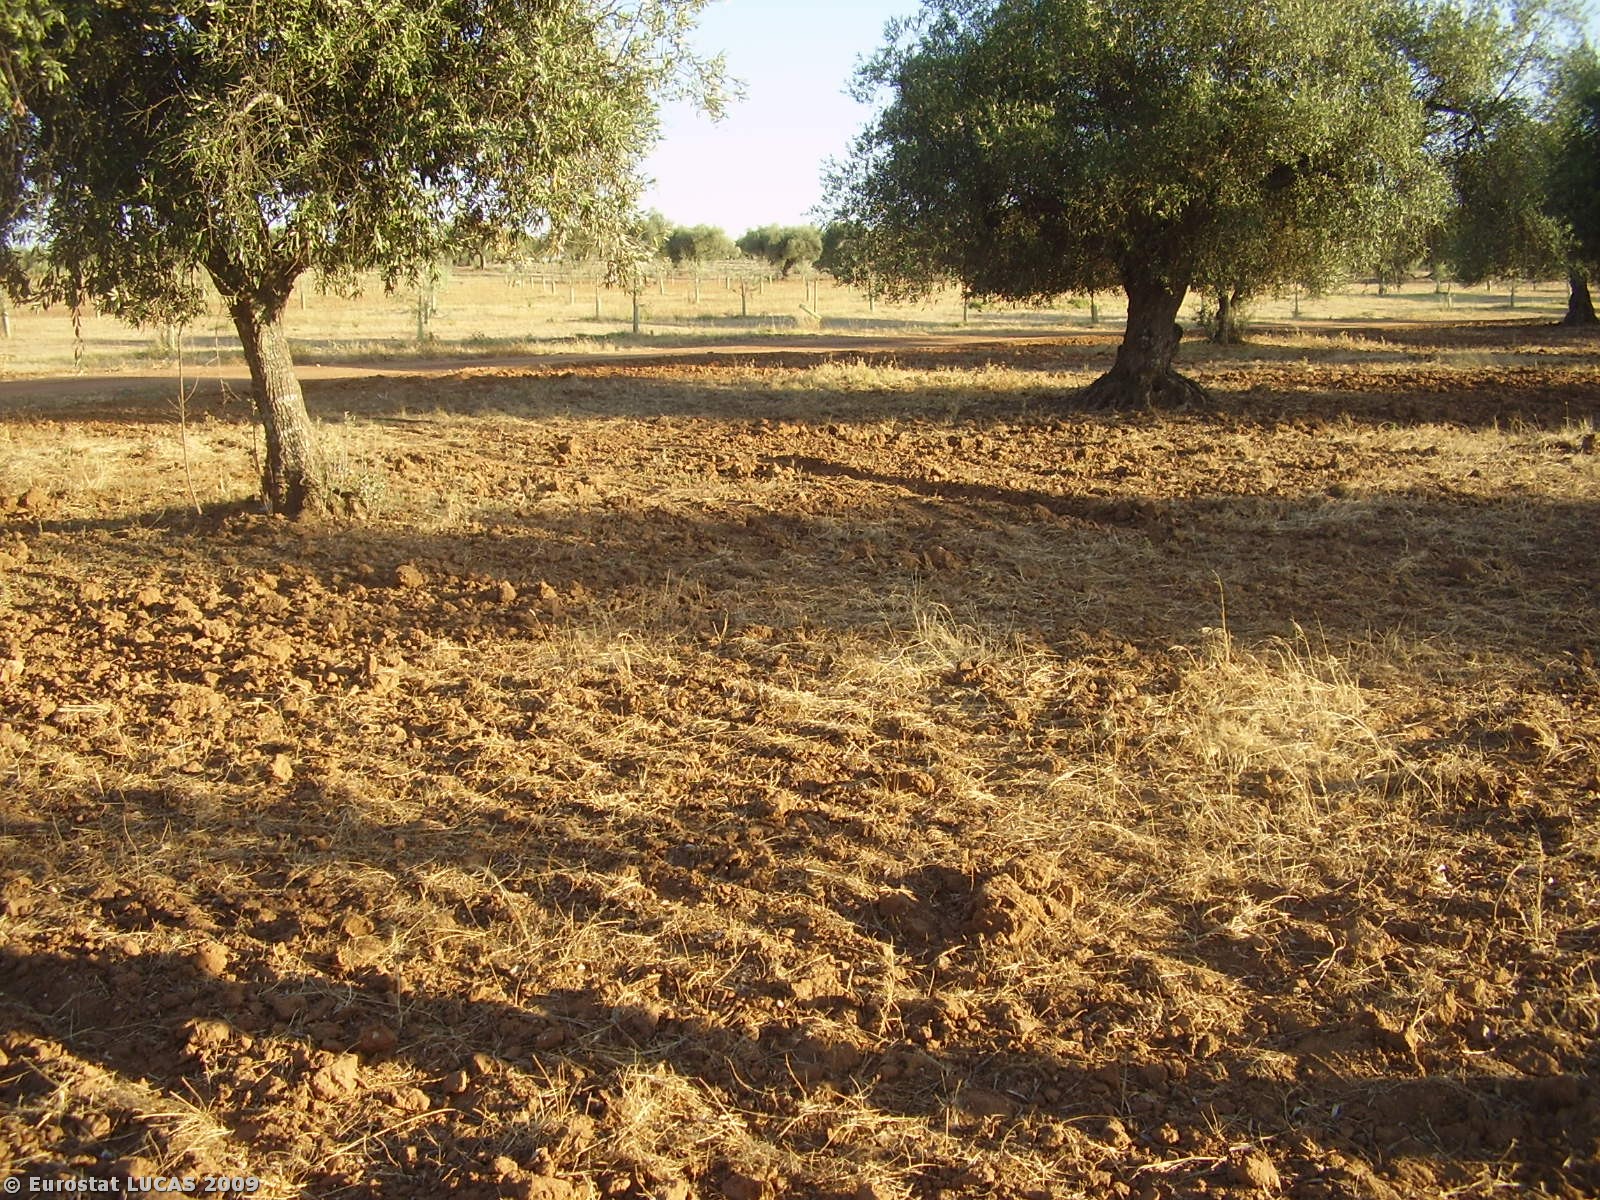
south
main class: Cropland
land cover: Olive groves
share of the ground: 10 - 25 %
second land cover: Spontaneously vegetated surfaces
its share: 10 - 25 %
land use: Agriculture (excluding fallow land and kitchen gardens)
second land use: Fallow land
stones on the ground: 25 - 50 %
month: August
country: PT
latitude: 38.0419
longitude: -7.5573
